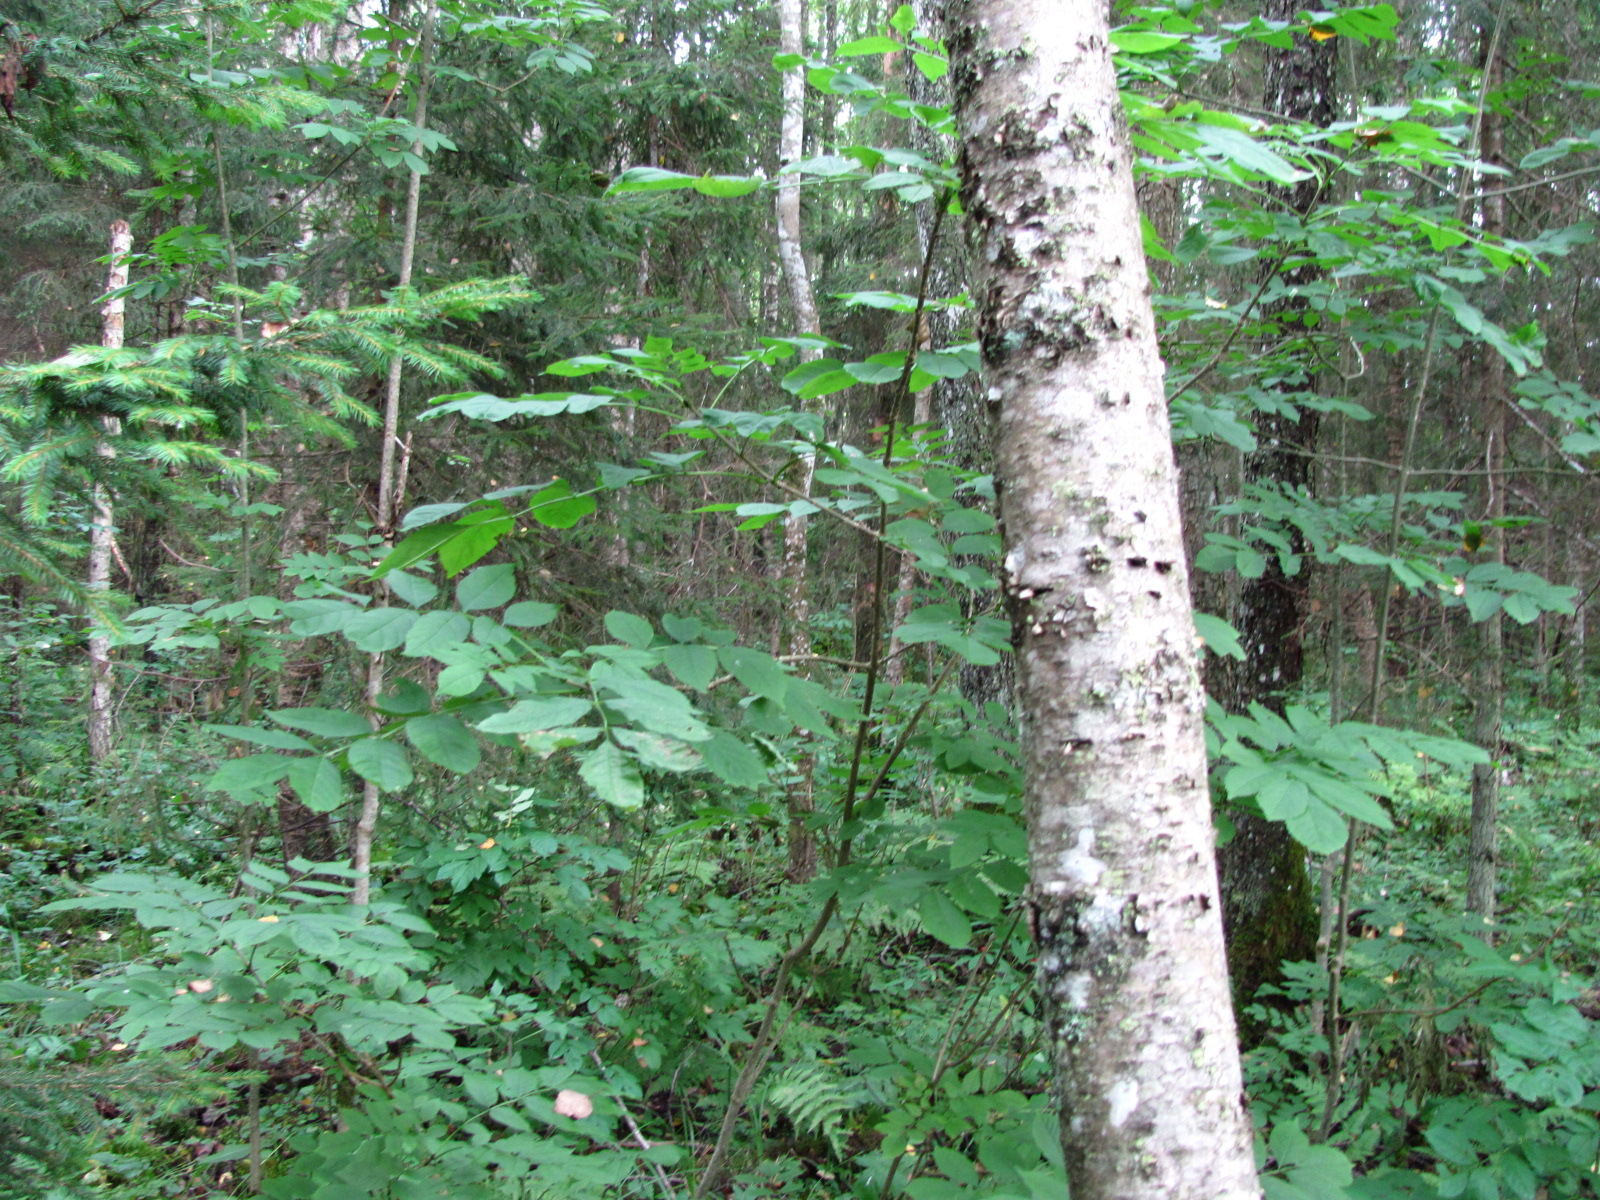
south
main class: Woodland
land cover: Spruce dominated mixed woodland
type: hemiboreal forest and nemoral coniferous forest and mixed broadleaved-coniferous forest
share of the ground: > 75 %
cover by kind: coniferous forest trees 40 %, broadleaved forest trees 40 %, herbaceous plants 10 %, lichens and mosses 10 %
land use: Forestry
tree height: > 5 m
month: September
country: LV
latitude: 56.7027
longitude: 25.2198
